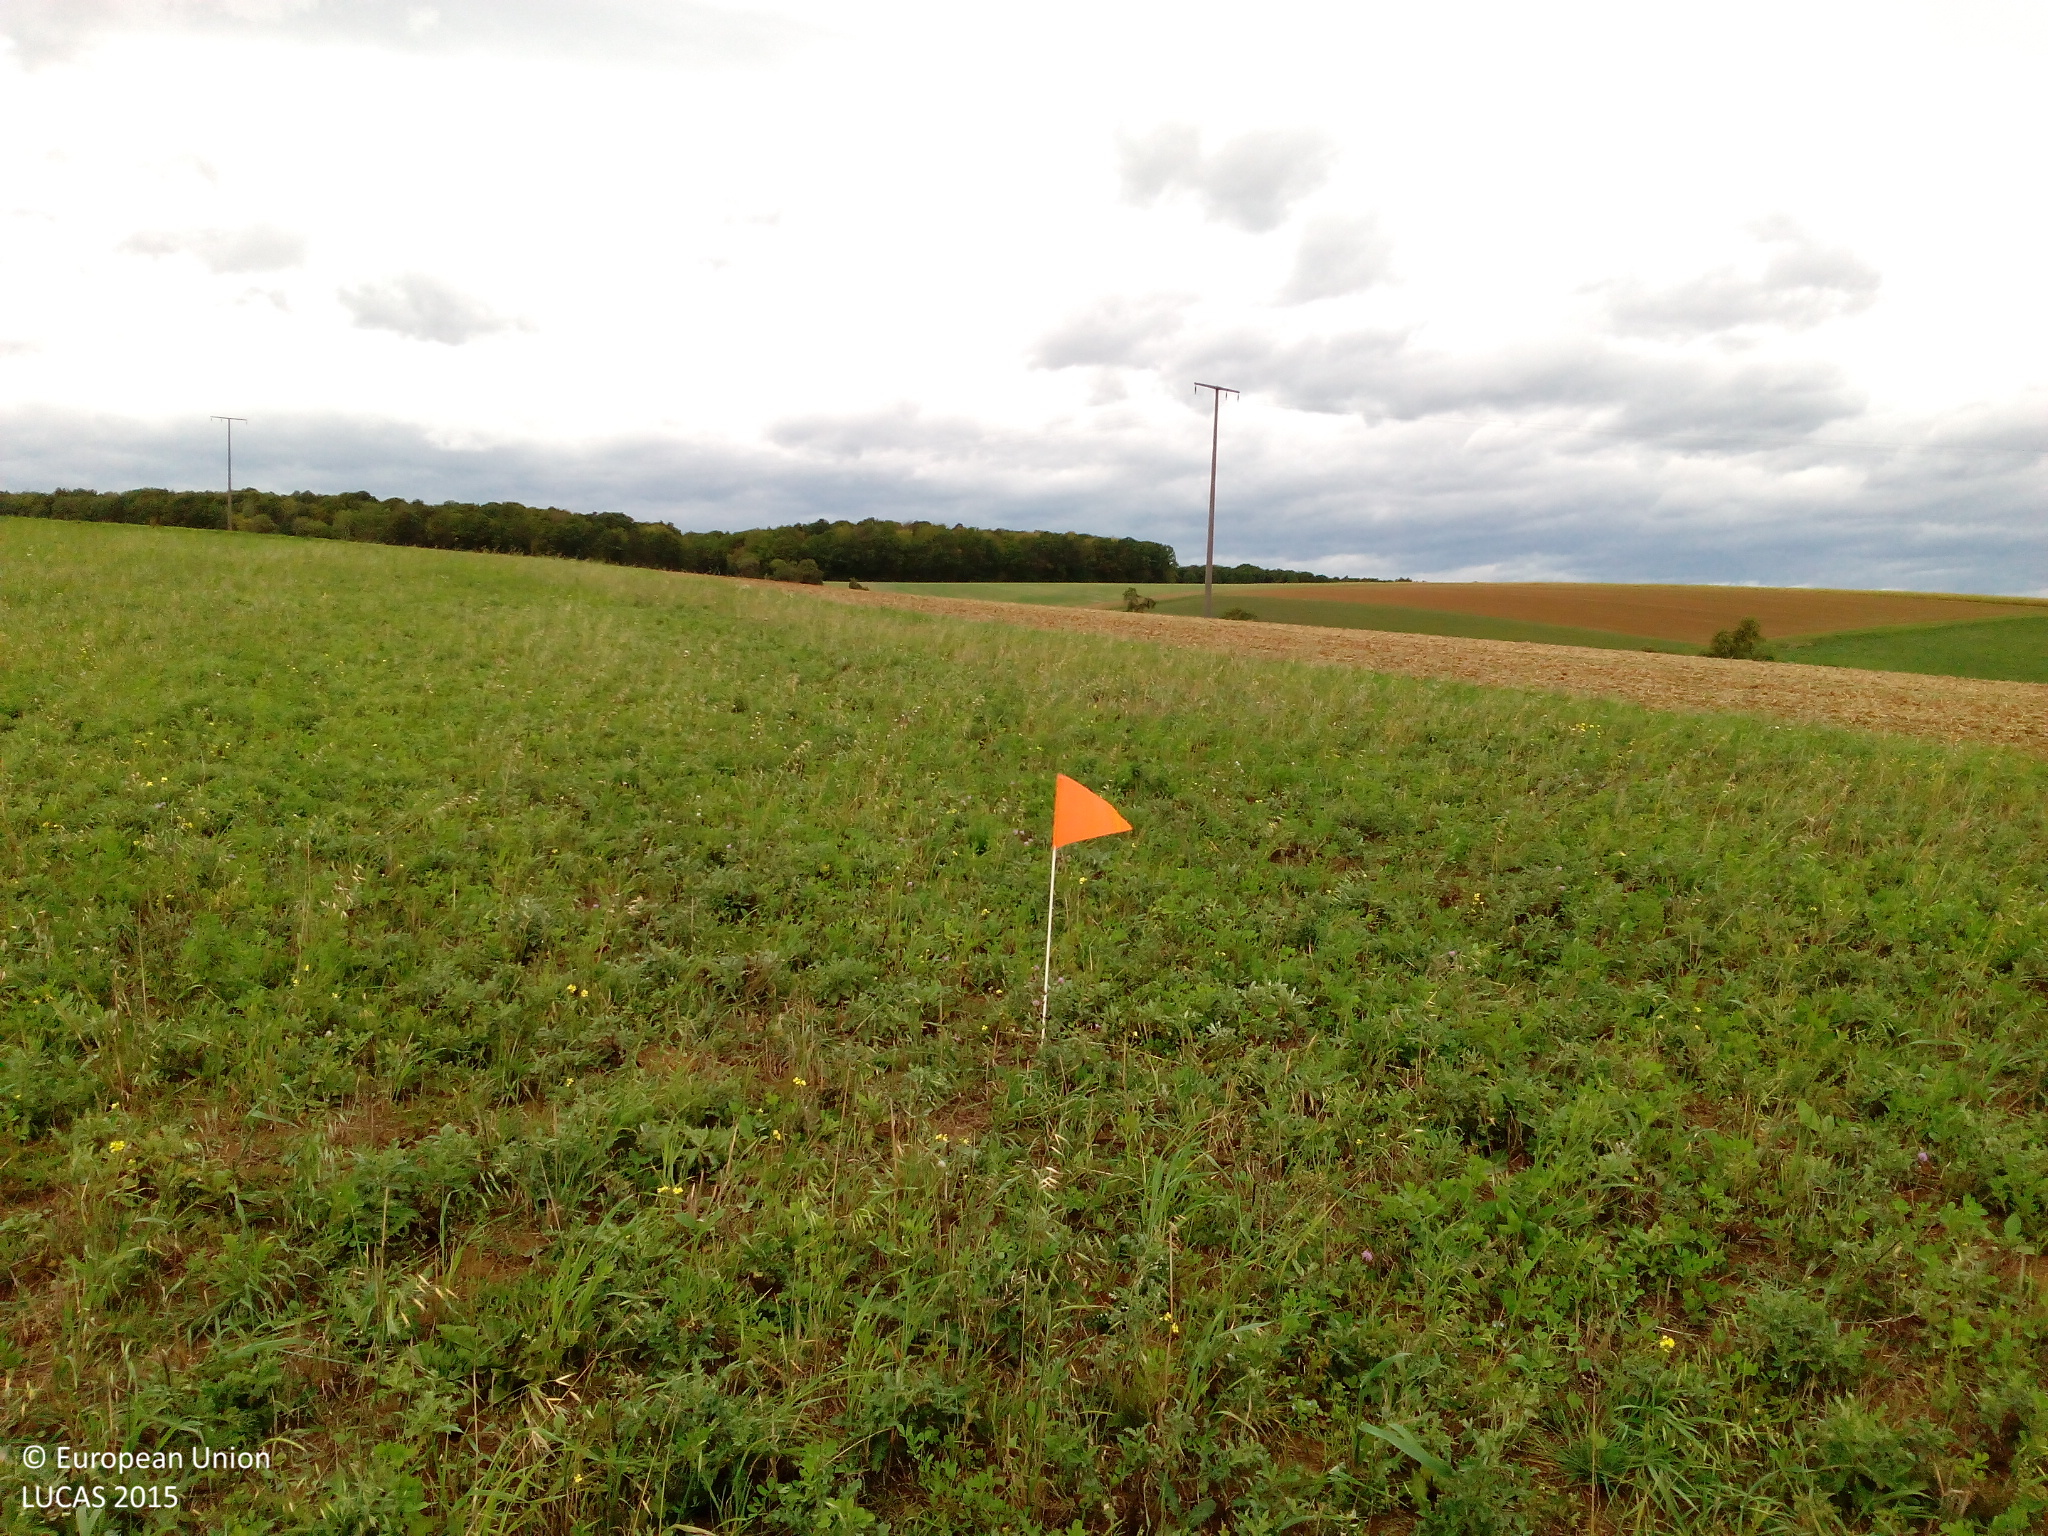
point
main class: Cropland
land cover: Other leguminous and mixtures for fodder
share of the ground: 50 - 75 %
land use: Agriculture (excluding fallow land and kitchen gardens)
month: September
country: DE
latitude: 50.0224
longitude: 9.9302
